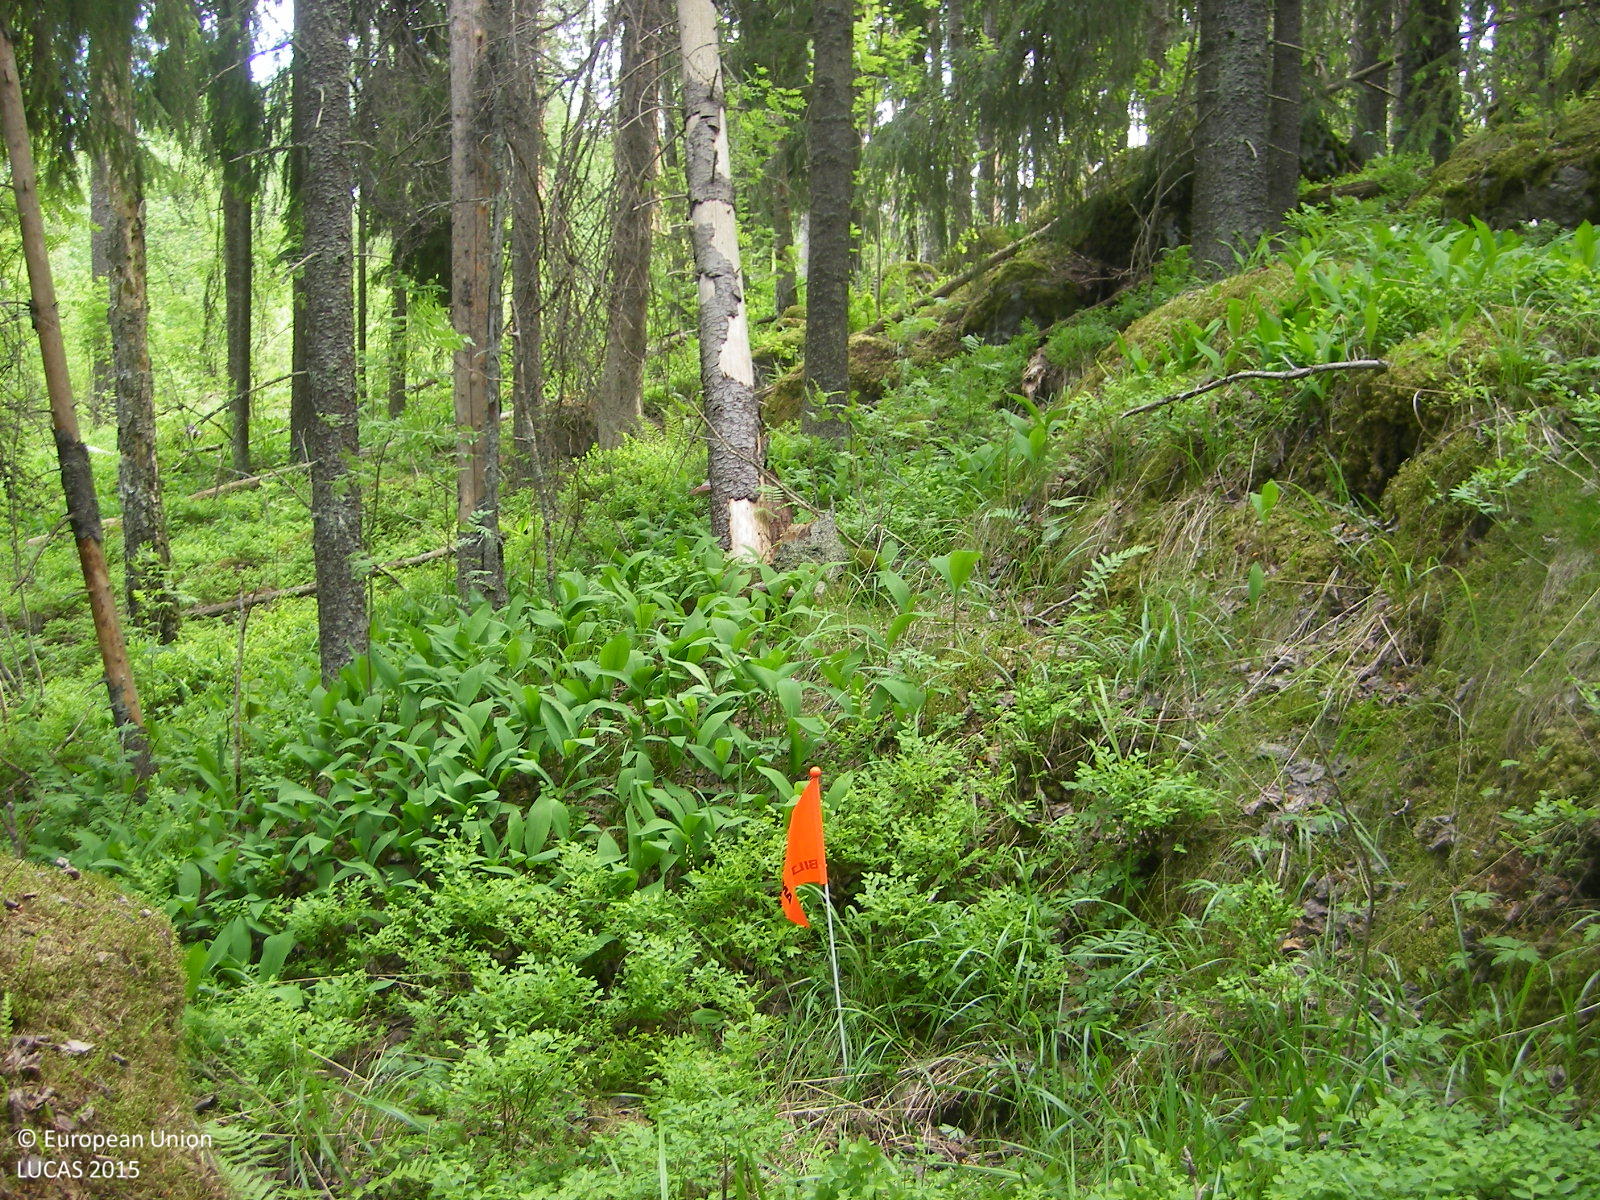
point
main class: Woodland
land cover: Spruce dominated mixed woodland
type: boreal forest
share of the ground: 50 - 75 %
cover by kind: broadleaved forest trees 40 %, coniferous forest trees 30 %, shrubs 15 %, herbaceous plants 10 %, lichens and mosses 5 %
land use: Forestry
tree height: > 5 m
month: June
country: FI
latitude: 60.3514
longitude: 24.7746
